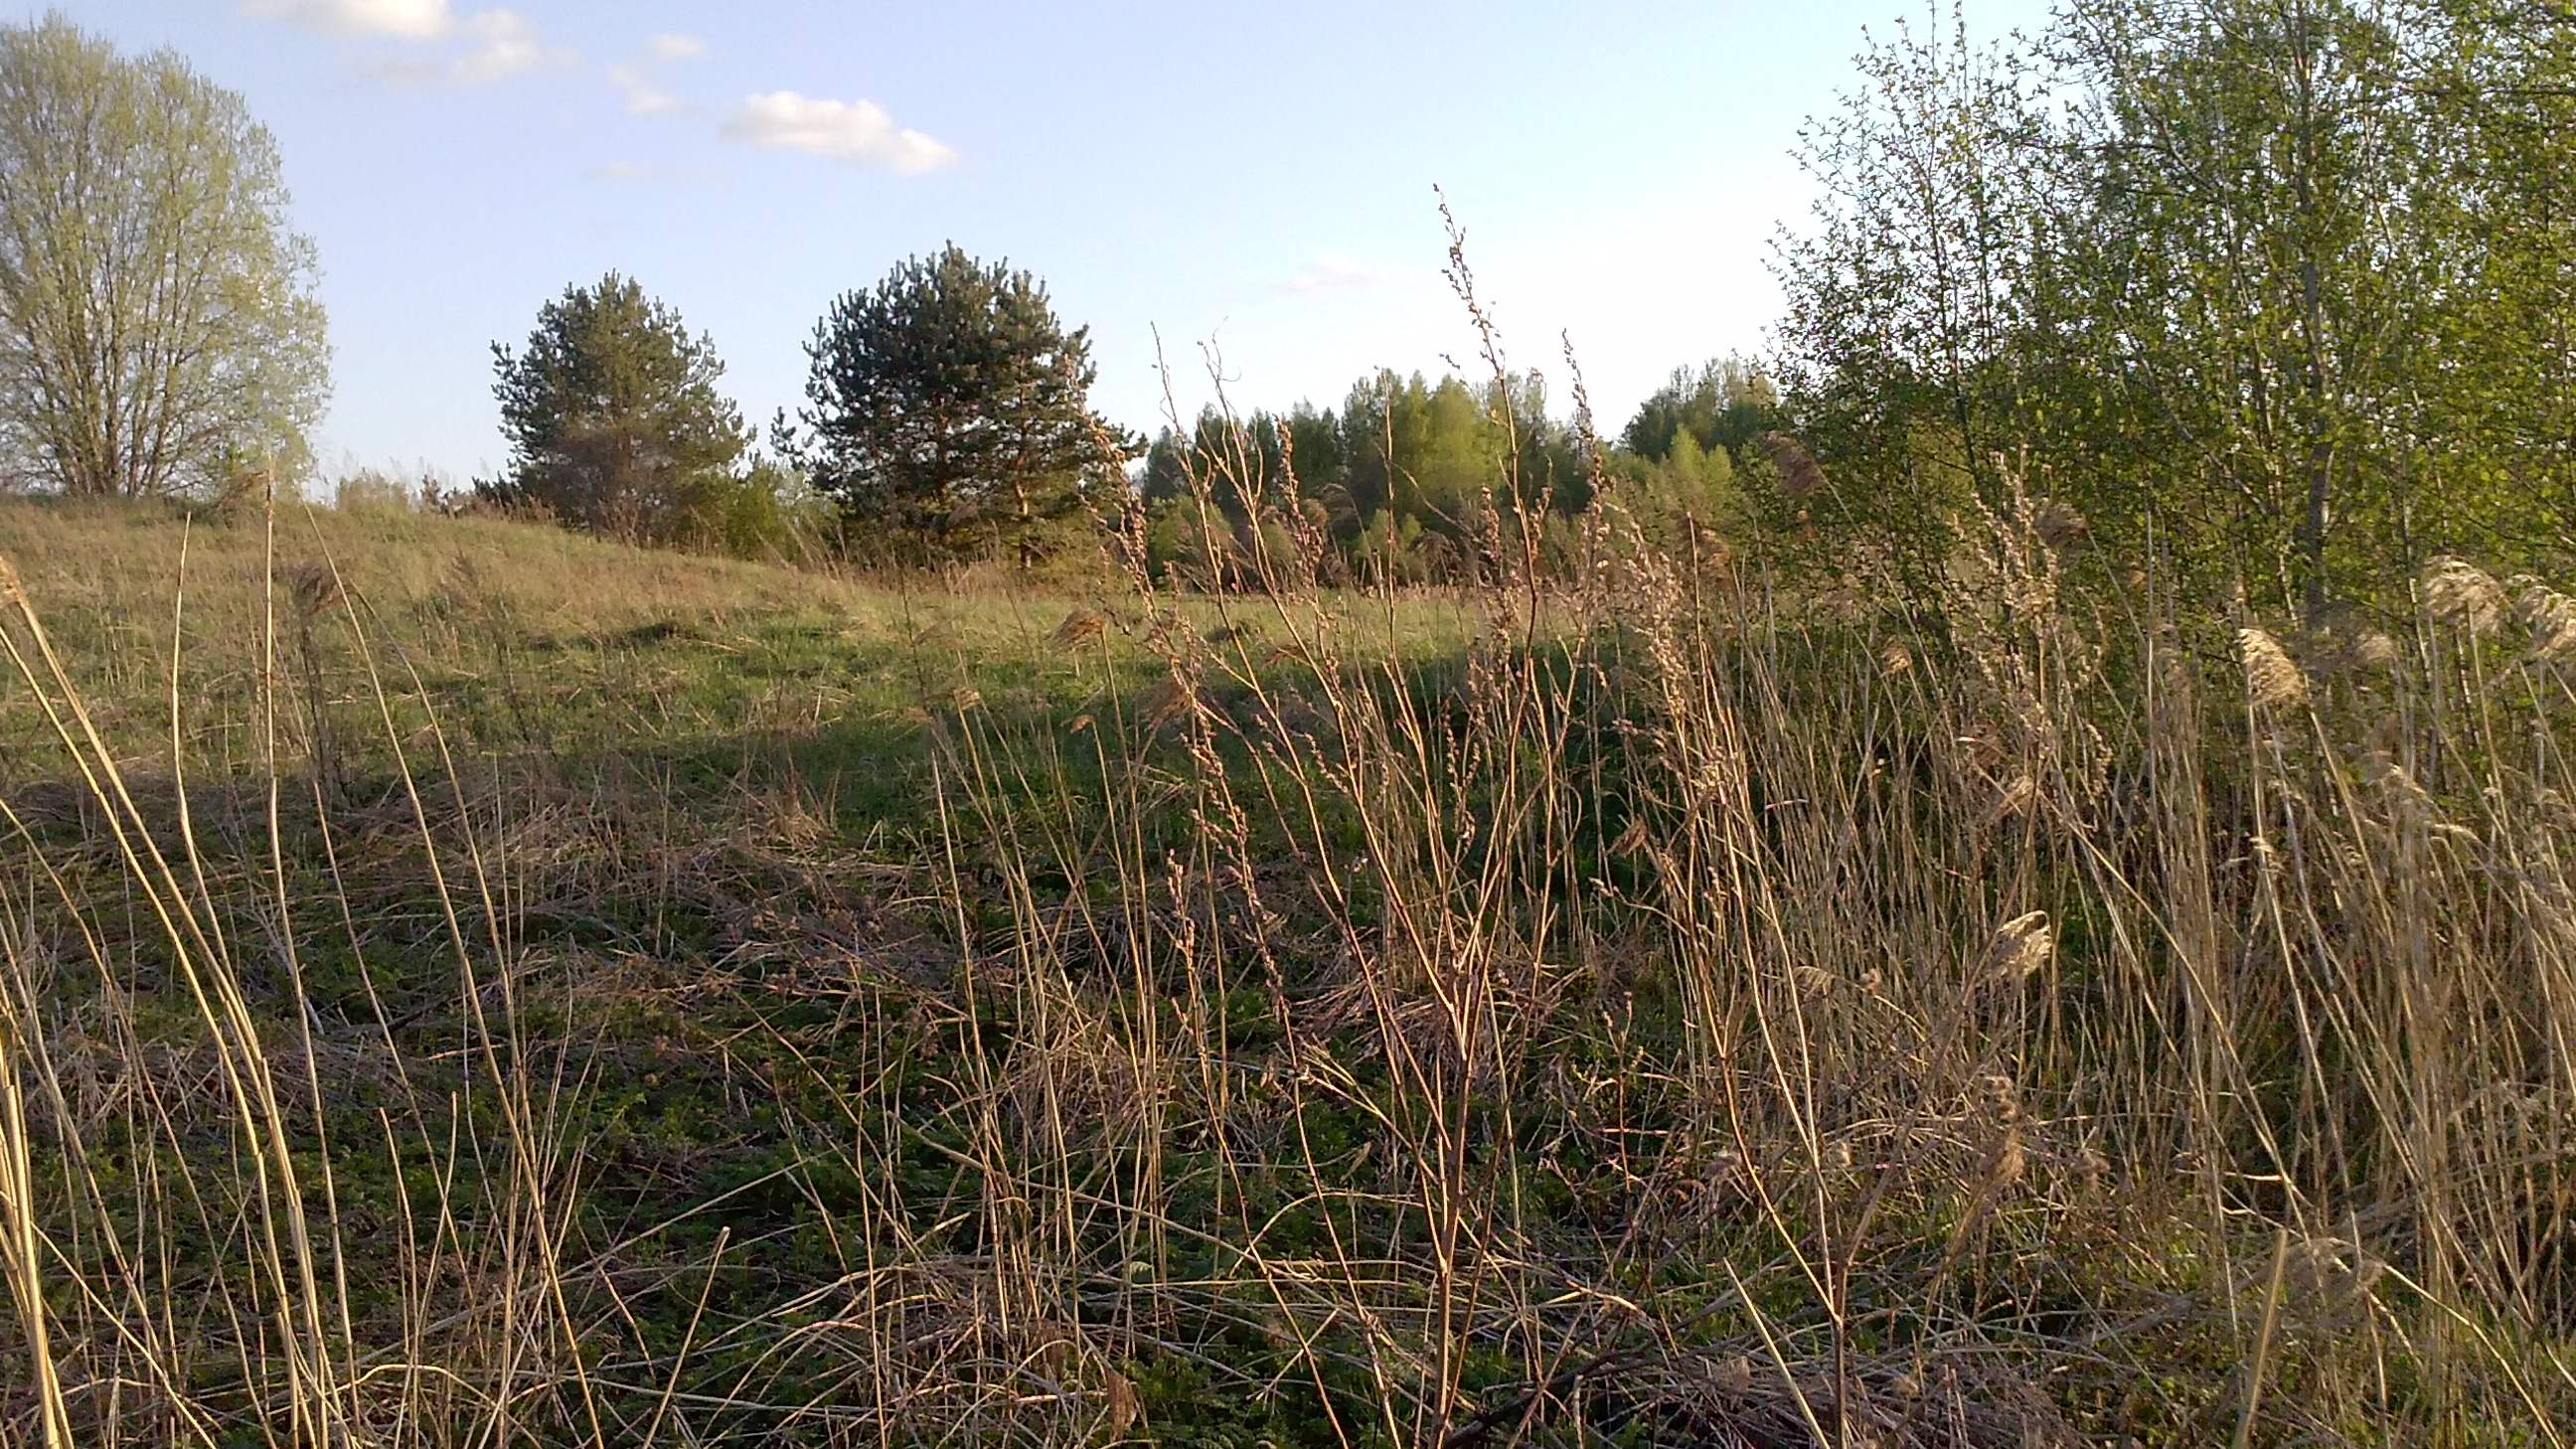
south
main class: Woodland
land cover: Broadleaved woodland
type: non-riverine alder, birch or aspen forest
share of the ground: > 75 %
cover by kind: broadleaved forest trees 100 %
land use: Forestry
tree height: > 5 m
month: May
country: LV
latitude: 56.1011
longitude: 27.1965
